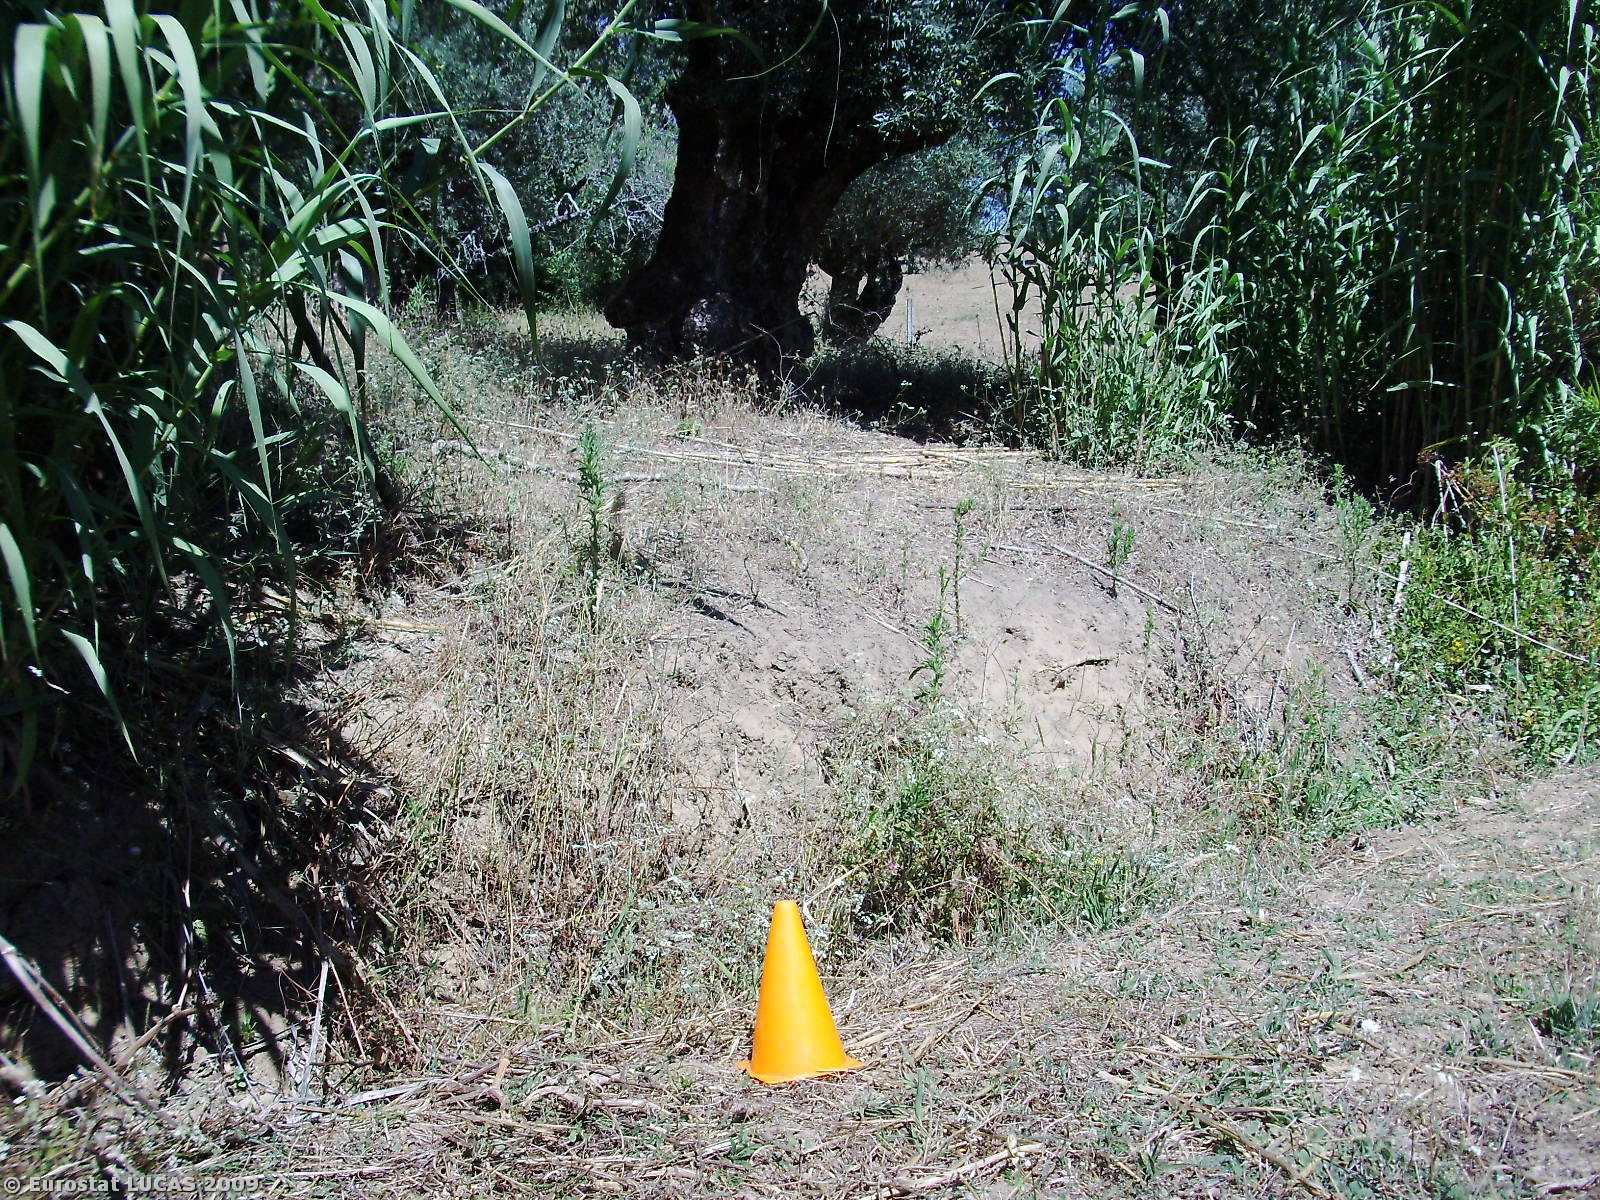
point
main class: Cropland
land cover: Olive groves
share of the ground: 10 - 25 %
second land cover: Spontaneously vegetated surfaces
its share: 50 - 75 %
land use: Agriculture (excluding fallow land and kitchen gardens)
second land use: Fallow land
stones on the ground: 10 - 25 %
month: July
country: PT
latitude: 39.4321
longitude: -8.7956
